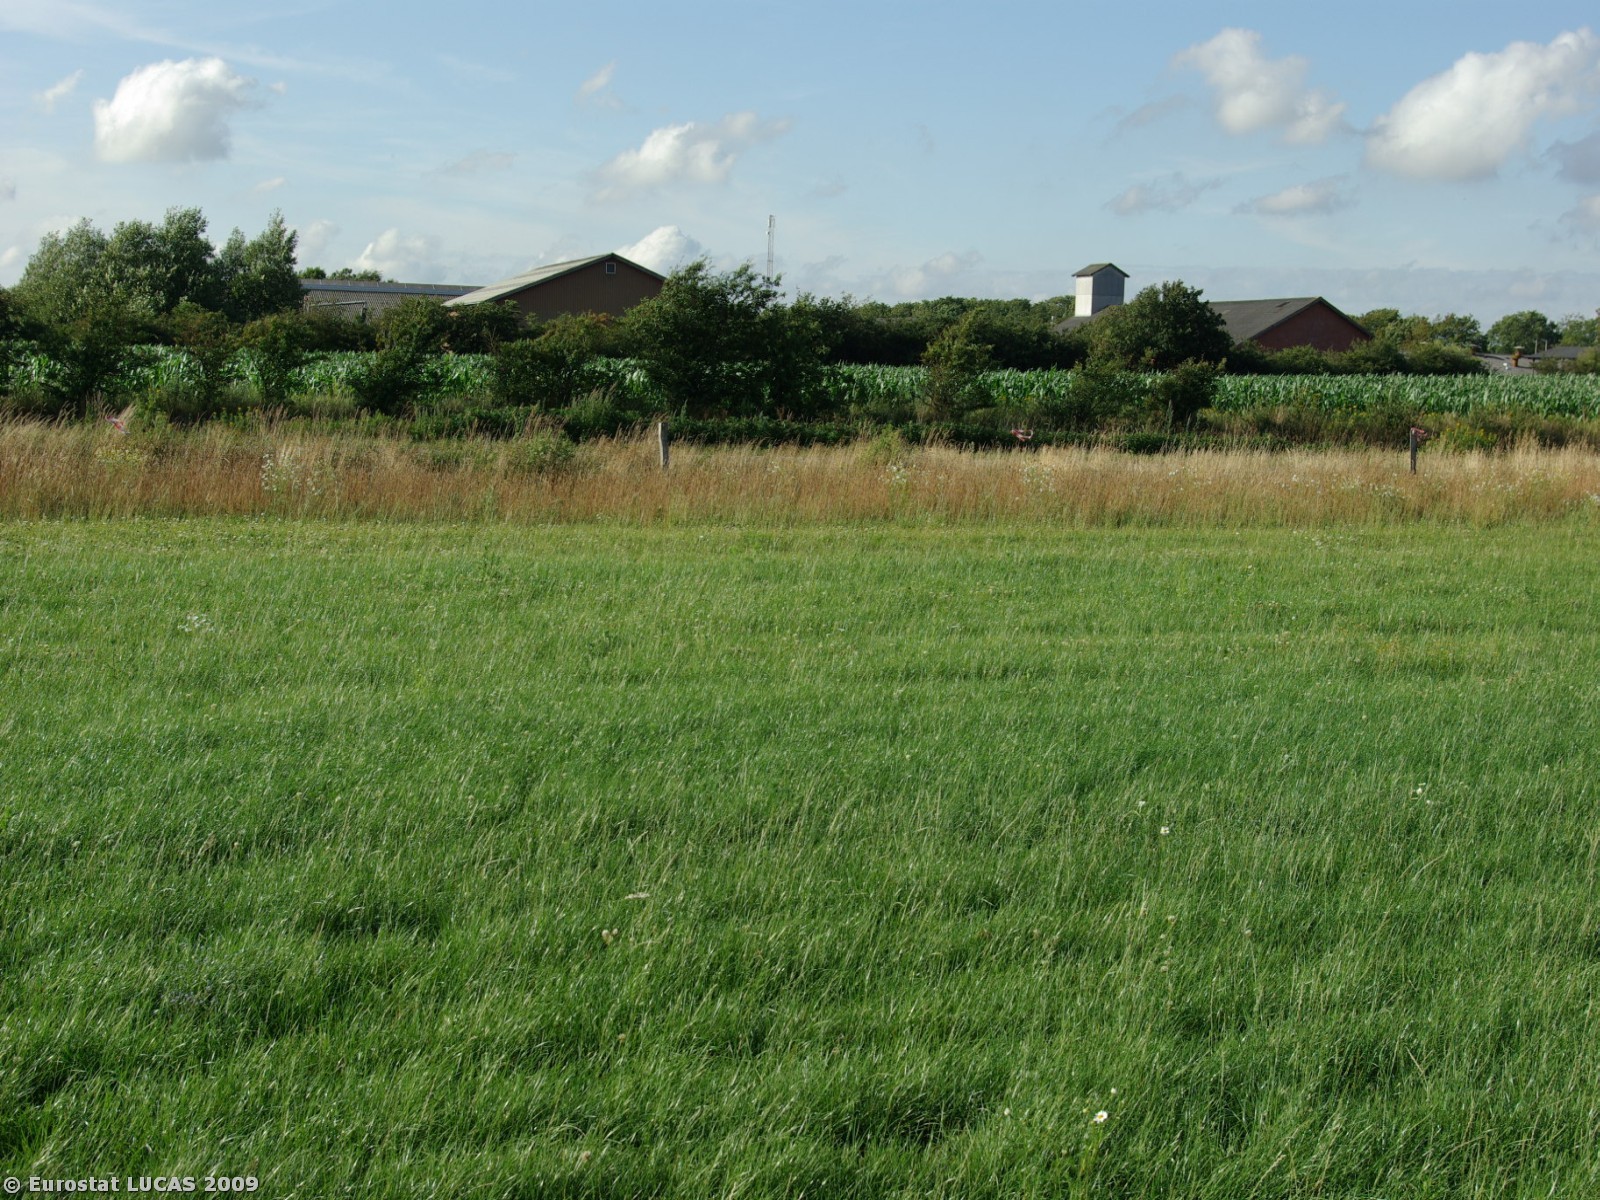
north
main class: Grassland
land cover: Grassland without tree/shrub cover
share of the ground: > 75 %
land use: Agriculture (excluding fallow land and kitchen gardens)
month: July
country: DK
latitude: 55.1763
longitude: 8.8861
